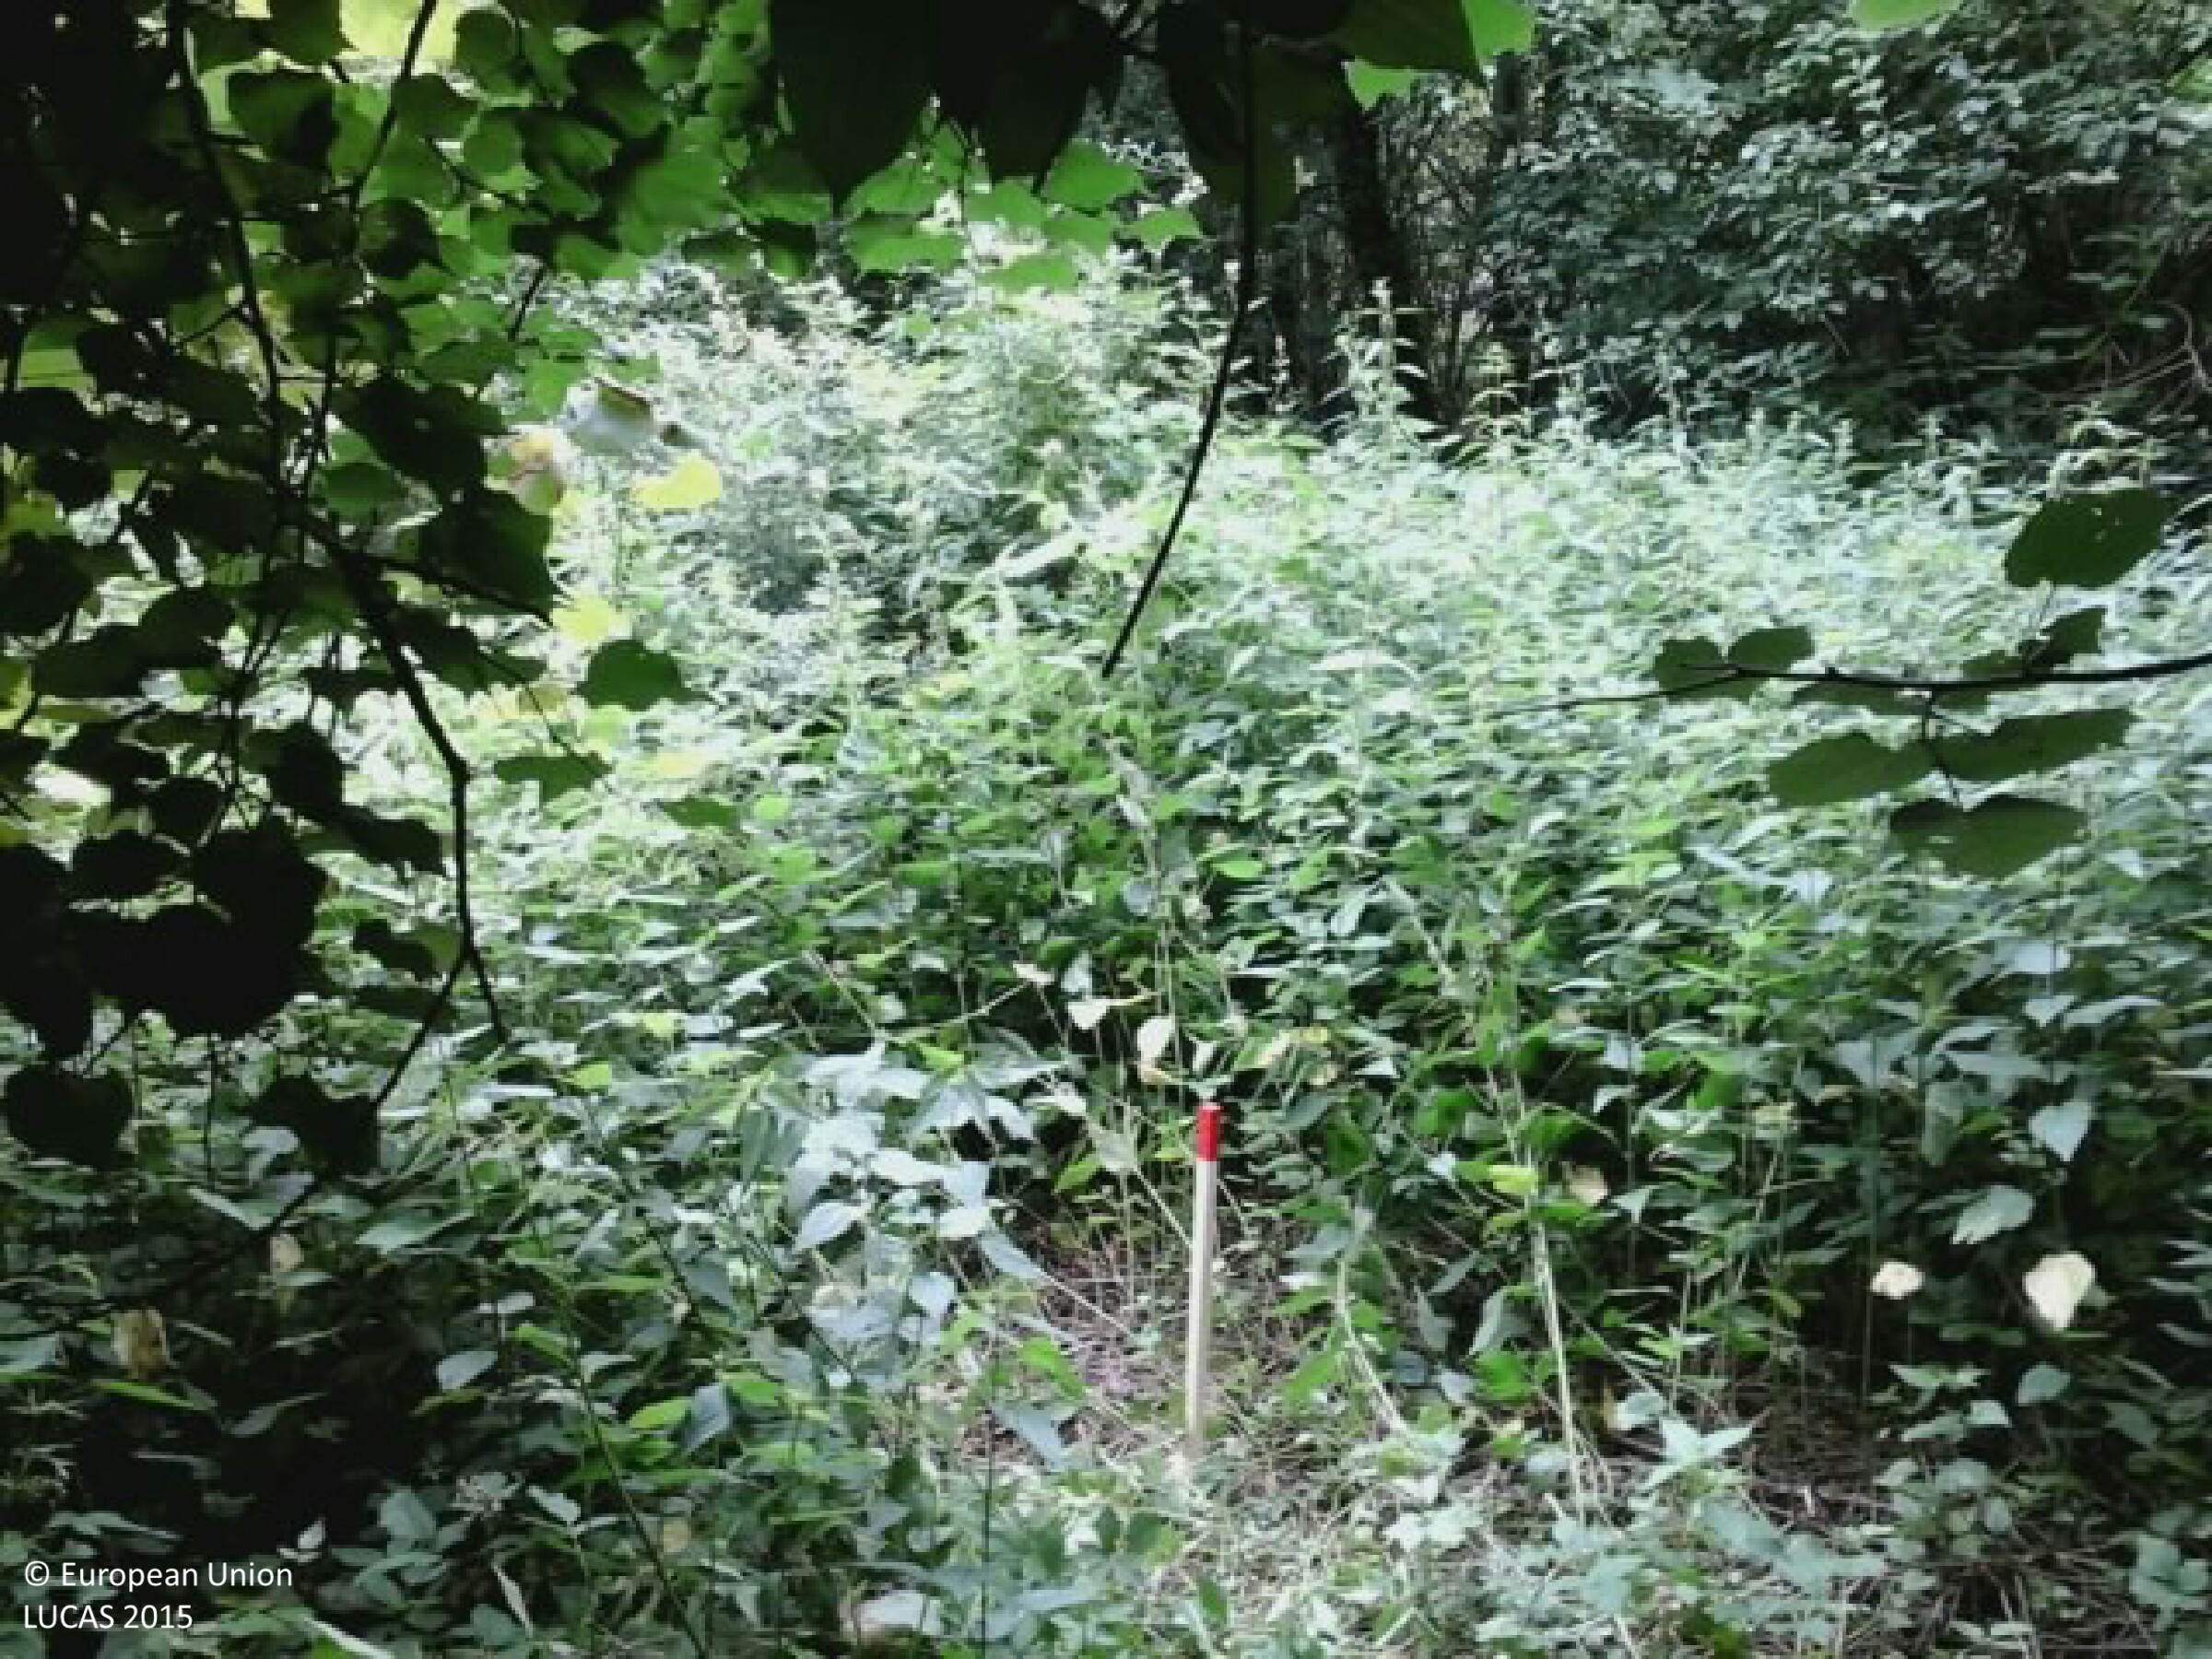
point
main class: Woodland
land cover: Broadleaved woodland
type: mesophytic deciduous forest
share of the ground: > 75 %
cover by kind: broadleaved forest trees 75 %, shrubs 15 %, herbaceous plants 10 %
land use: Forestry
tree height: > 5 m
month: June
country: HU
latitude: 46.2809
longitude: 17.8317
